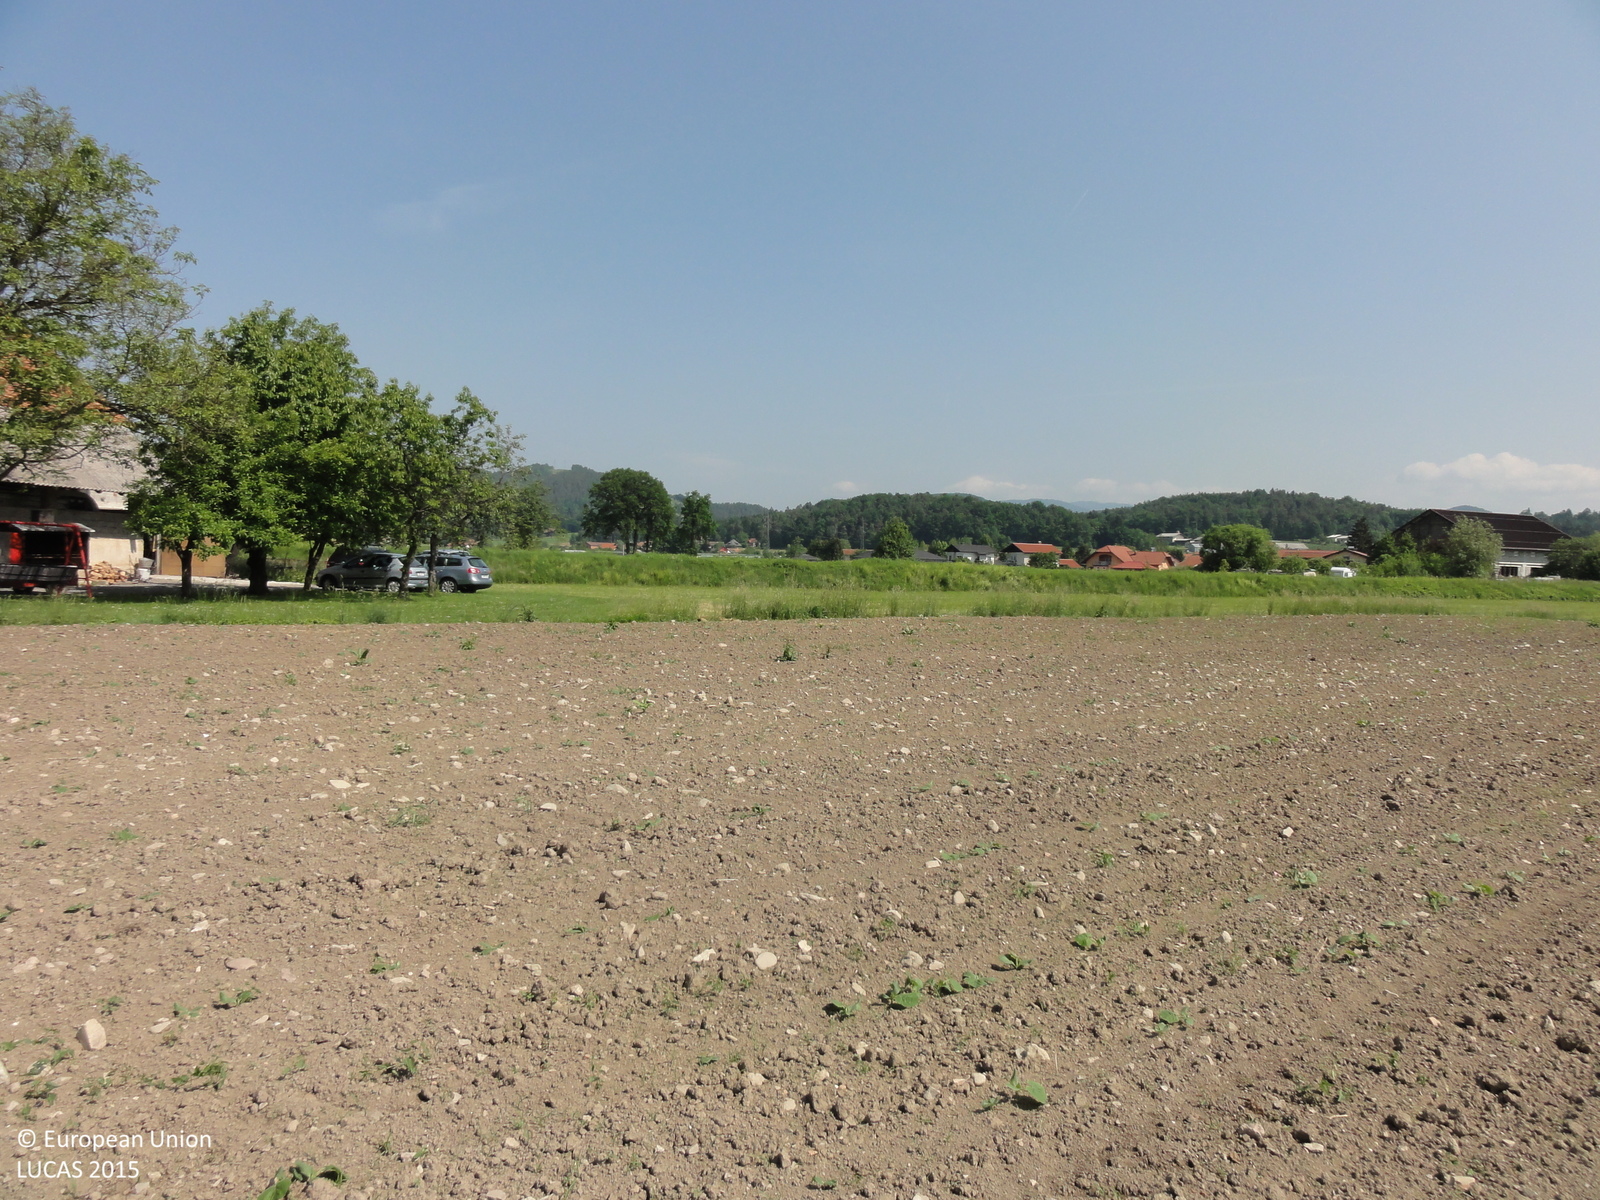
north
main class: Cropland
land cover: Other fresh vegetables
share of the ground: < 10 %
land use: Agriculture (excluding fallow land and kitchen gardens)
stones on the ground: 10 - 25 %
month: May
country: SI
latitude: 46.2634
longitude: 15.1483
